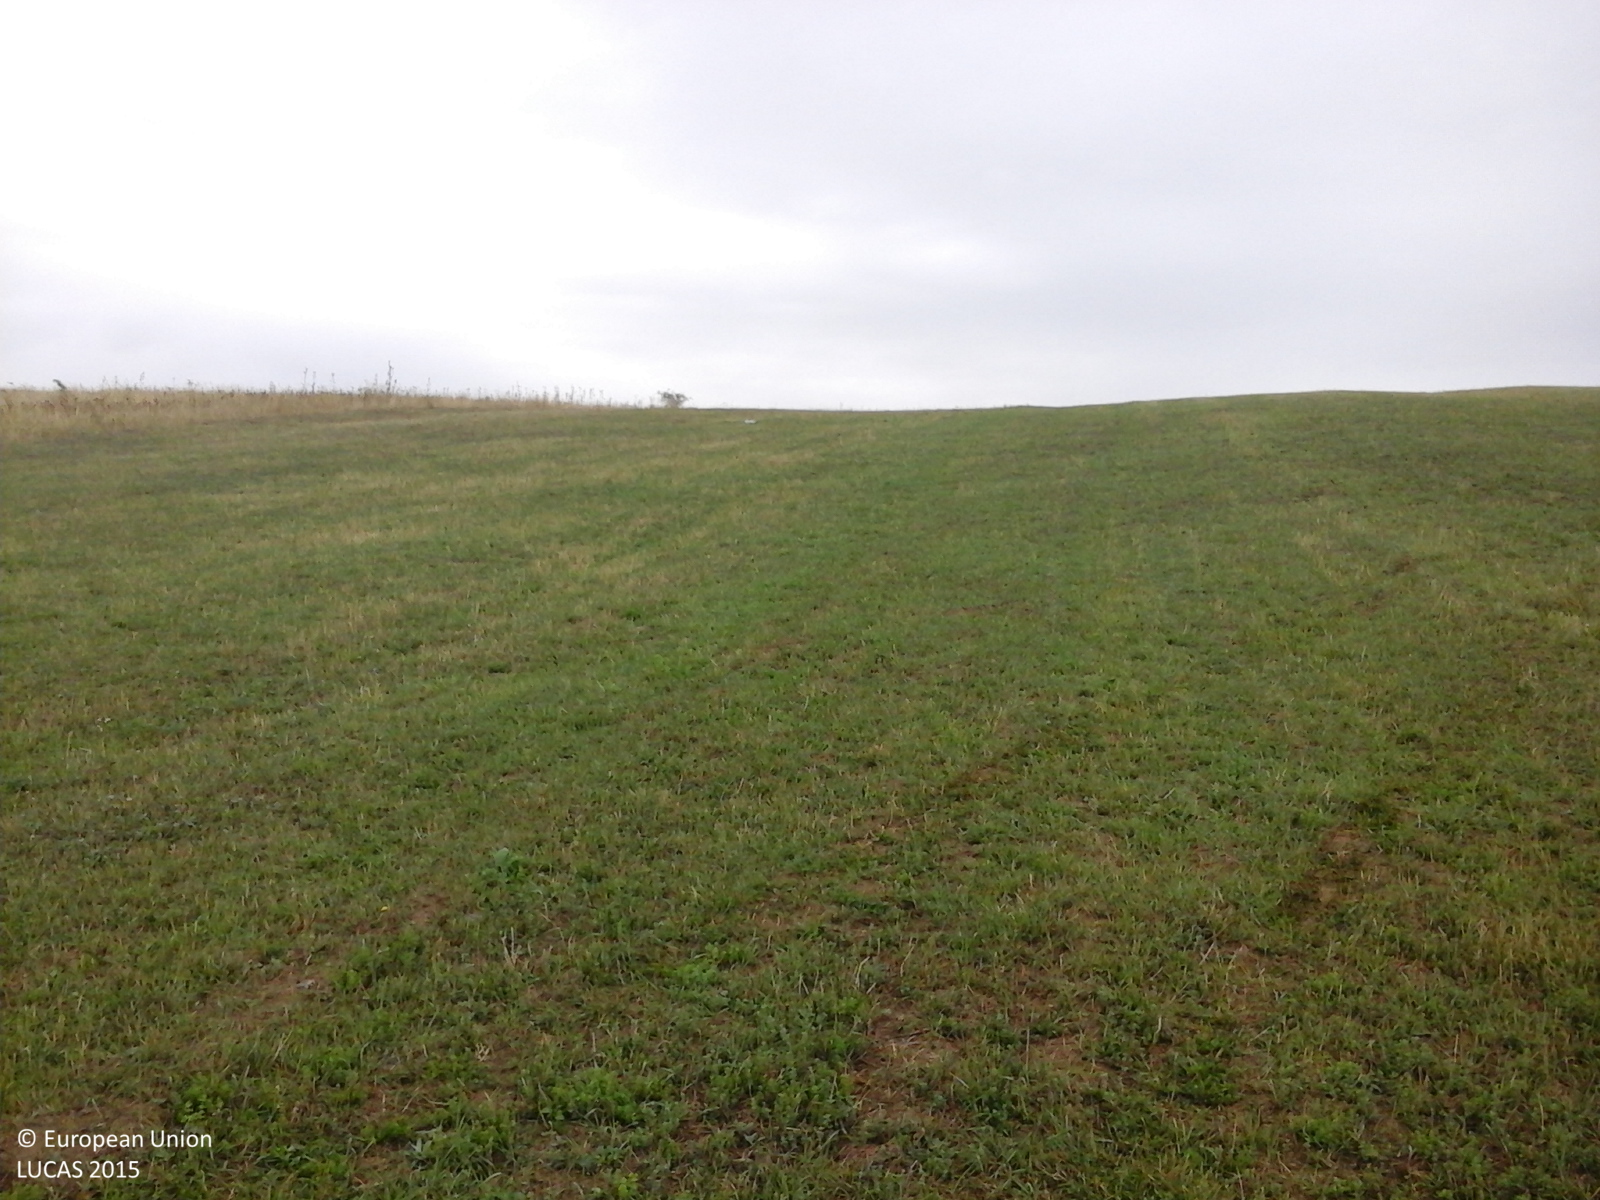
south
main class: Grassland
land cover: Grassland without tree/shrub cover
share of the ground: > 75 %
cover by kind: herbaceous plants 100 %
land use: Agriculture (excluding fallow land and kitchen gardens)
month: September
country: RO
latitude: 45.5410
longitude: 22.0394
